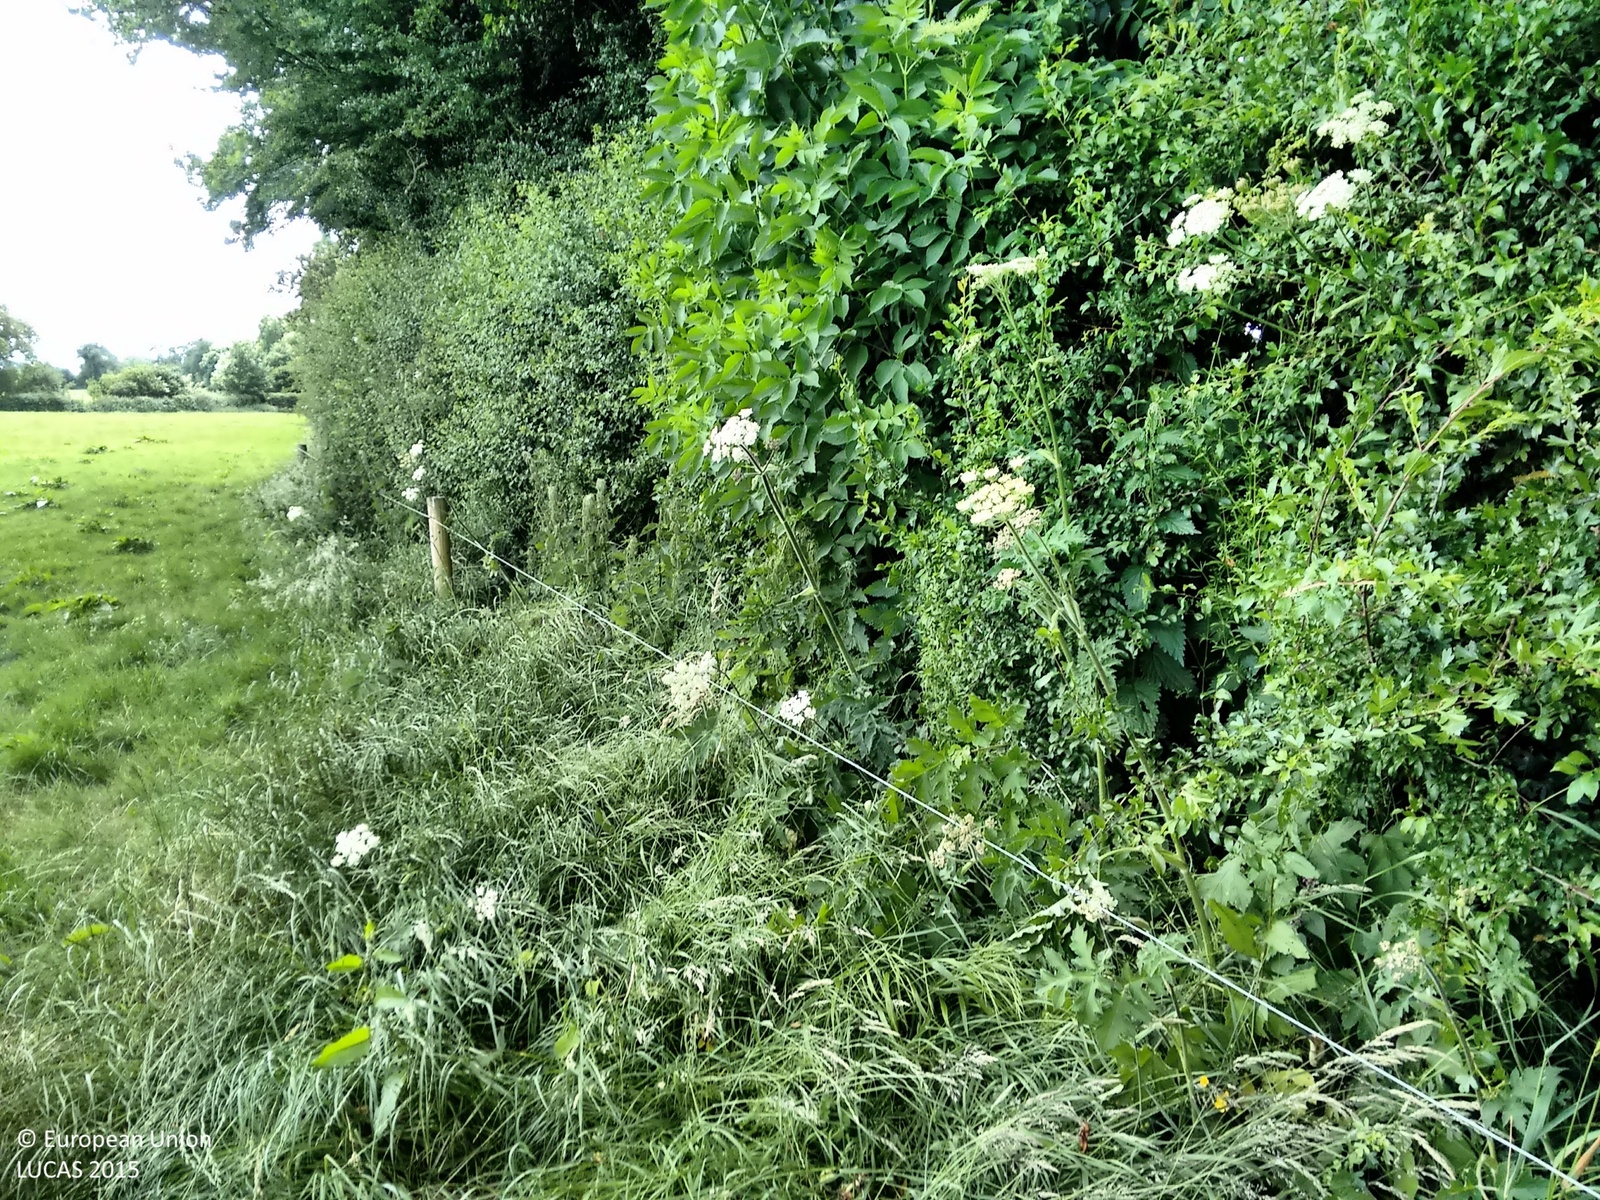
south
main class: Grassland
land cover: Grassland without tree/shrub cover
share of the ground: > 75 %
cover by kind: herbaceous plants 100 %
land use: Agriculture (excluding fallow land and kitchen gardens)
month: July
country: IE
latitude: 52.5175
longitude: -7.7481
